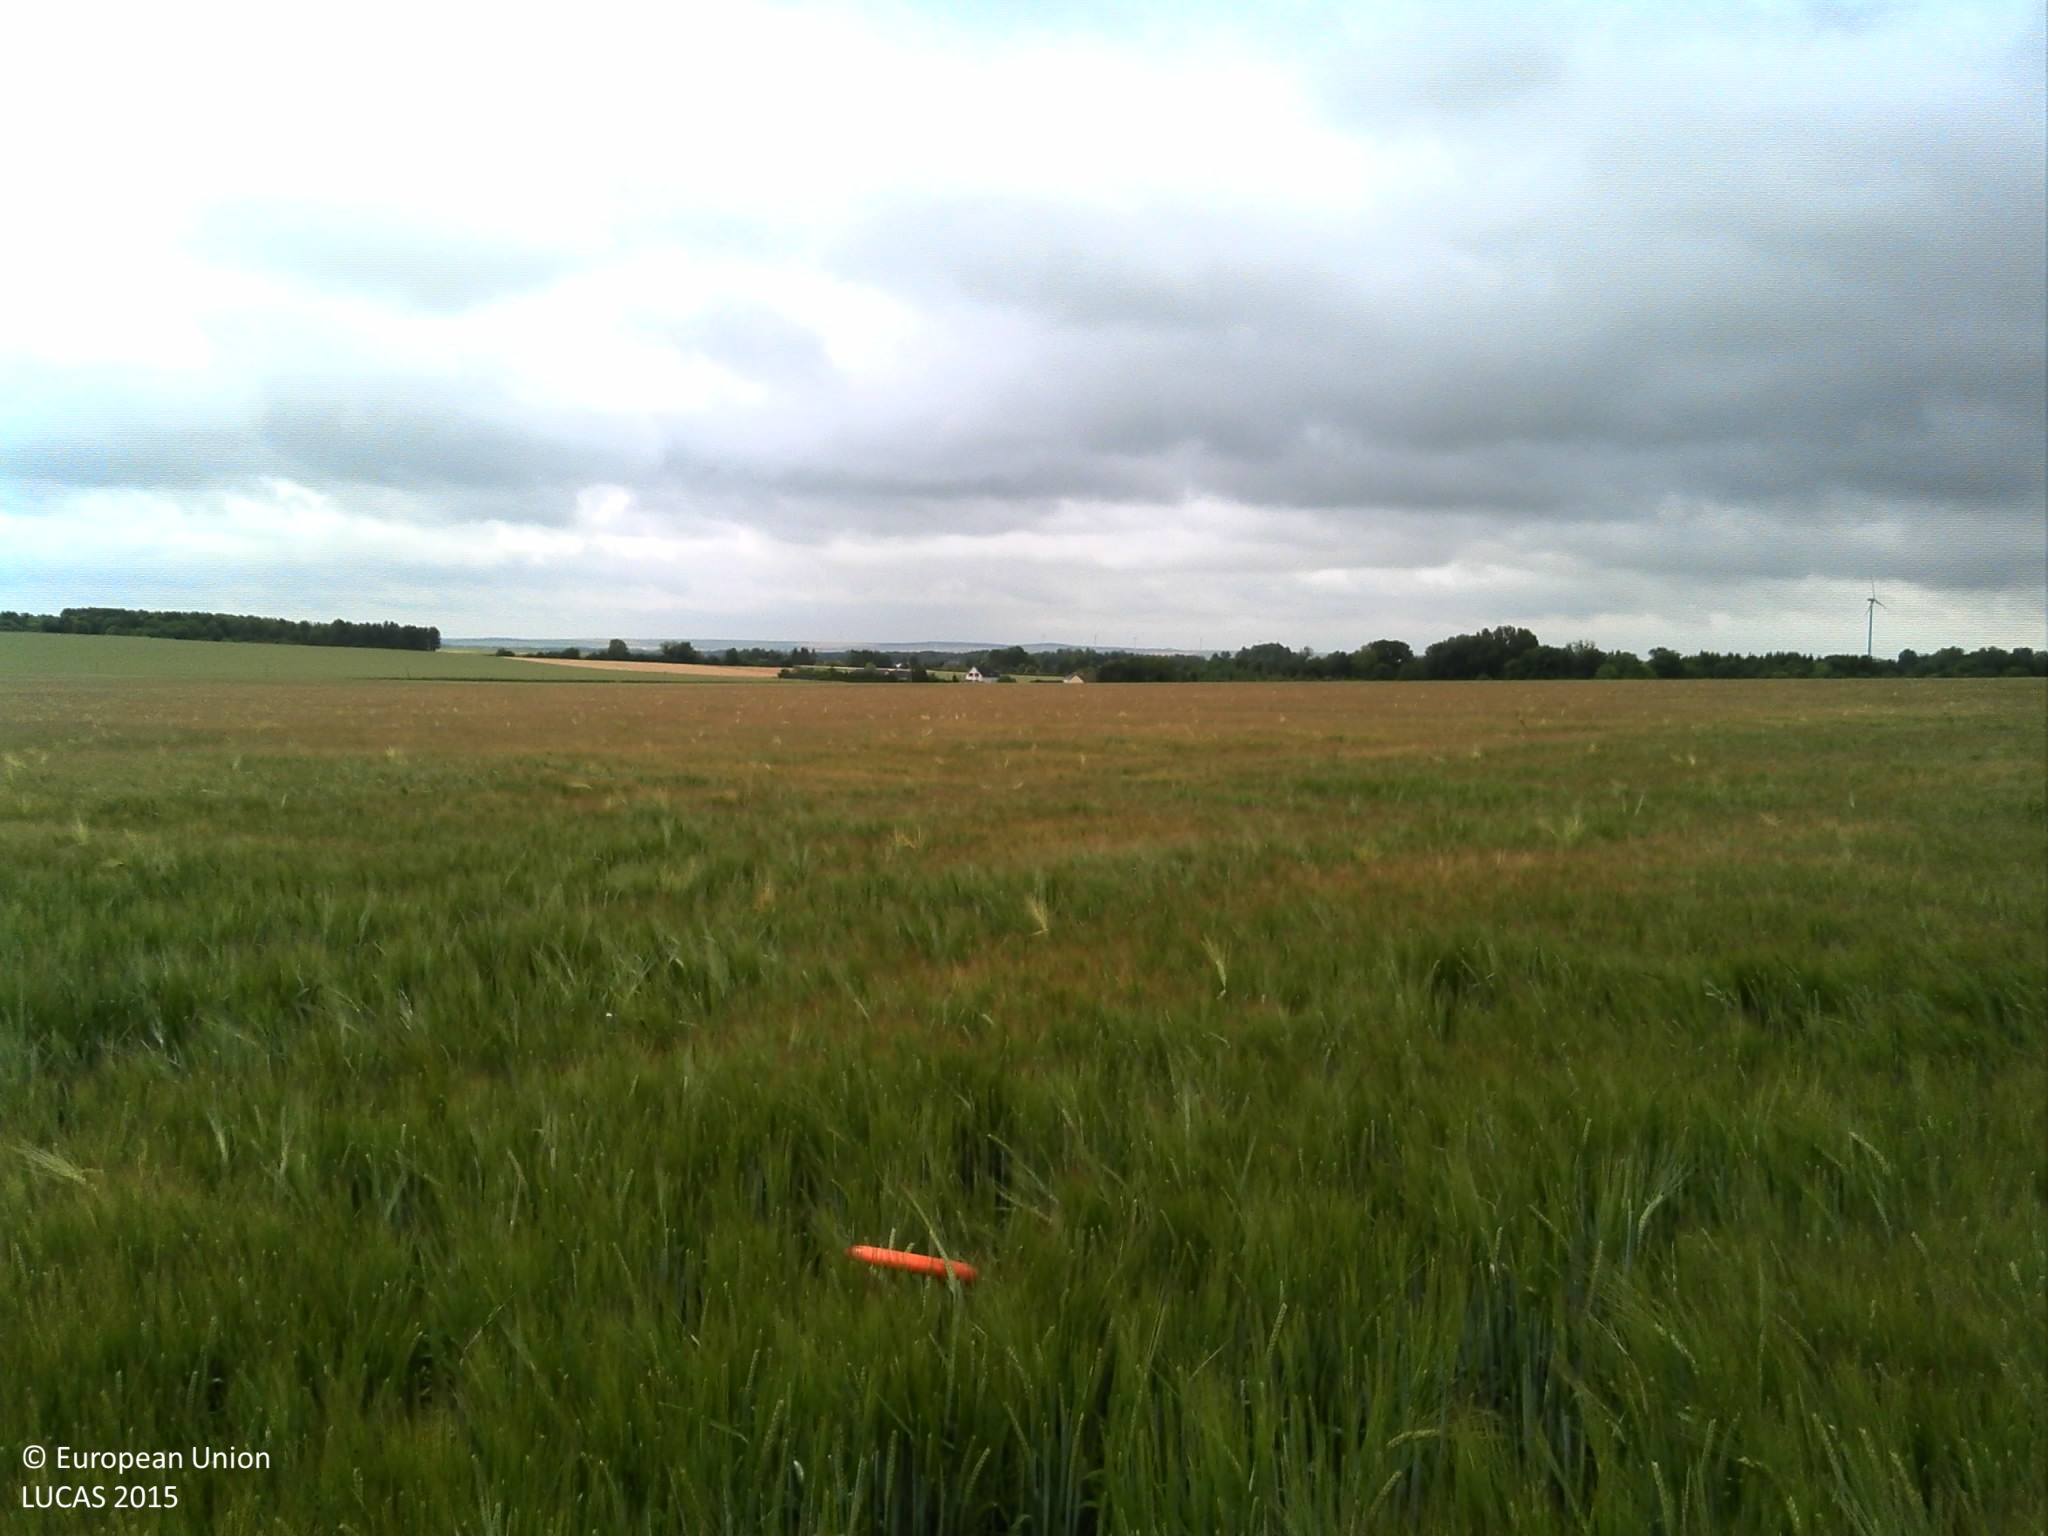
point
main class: Cropland
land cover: Barley
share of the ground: > 75 %
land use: Agriculture (excluding fallow land and kitchen gardens)
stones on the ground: < 10 %
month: June
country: FR
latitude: 48.5792
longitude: 4.2628
